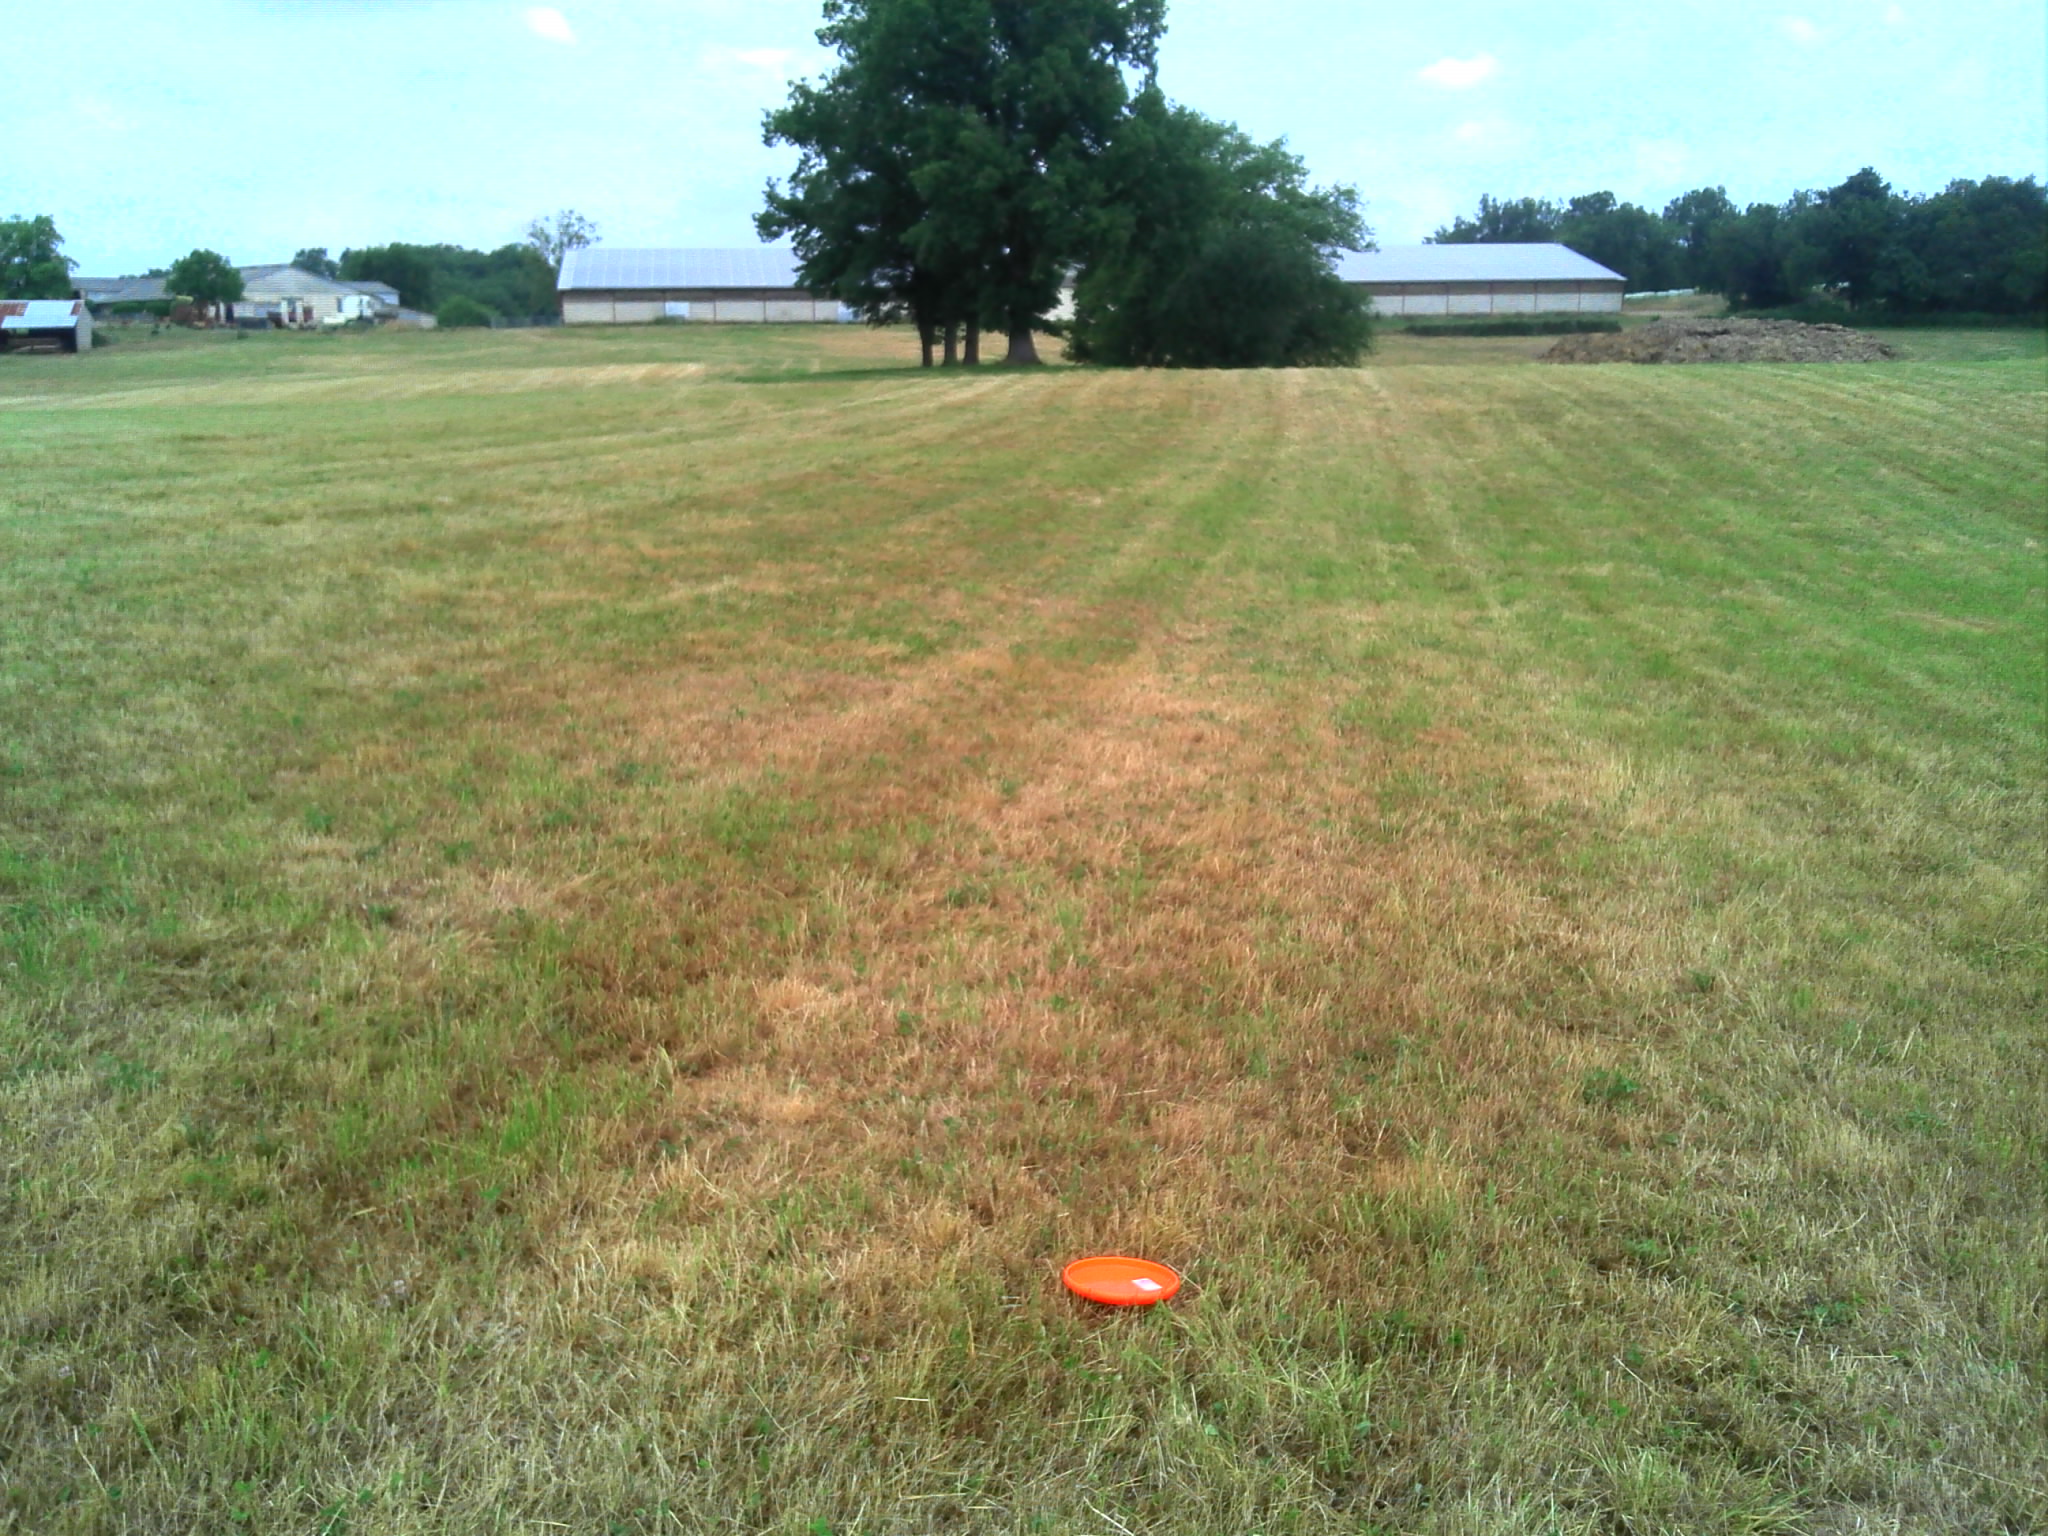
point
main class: Grassland
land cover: Grassland without tree/shrub cover
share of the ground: > 75 %
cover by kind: herbaceous plants 100 %
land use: Agriculture (excluding fallow land and kitchen gardens)
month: June
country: FR
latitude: 44.6967
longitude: 1.8088
